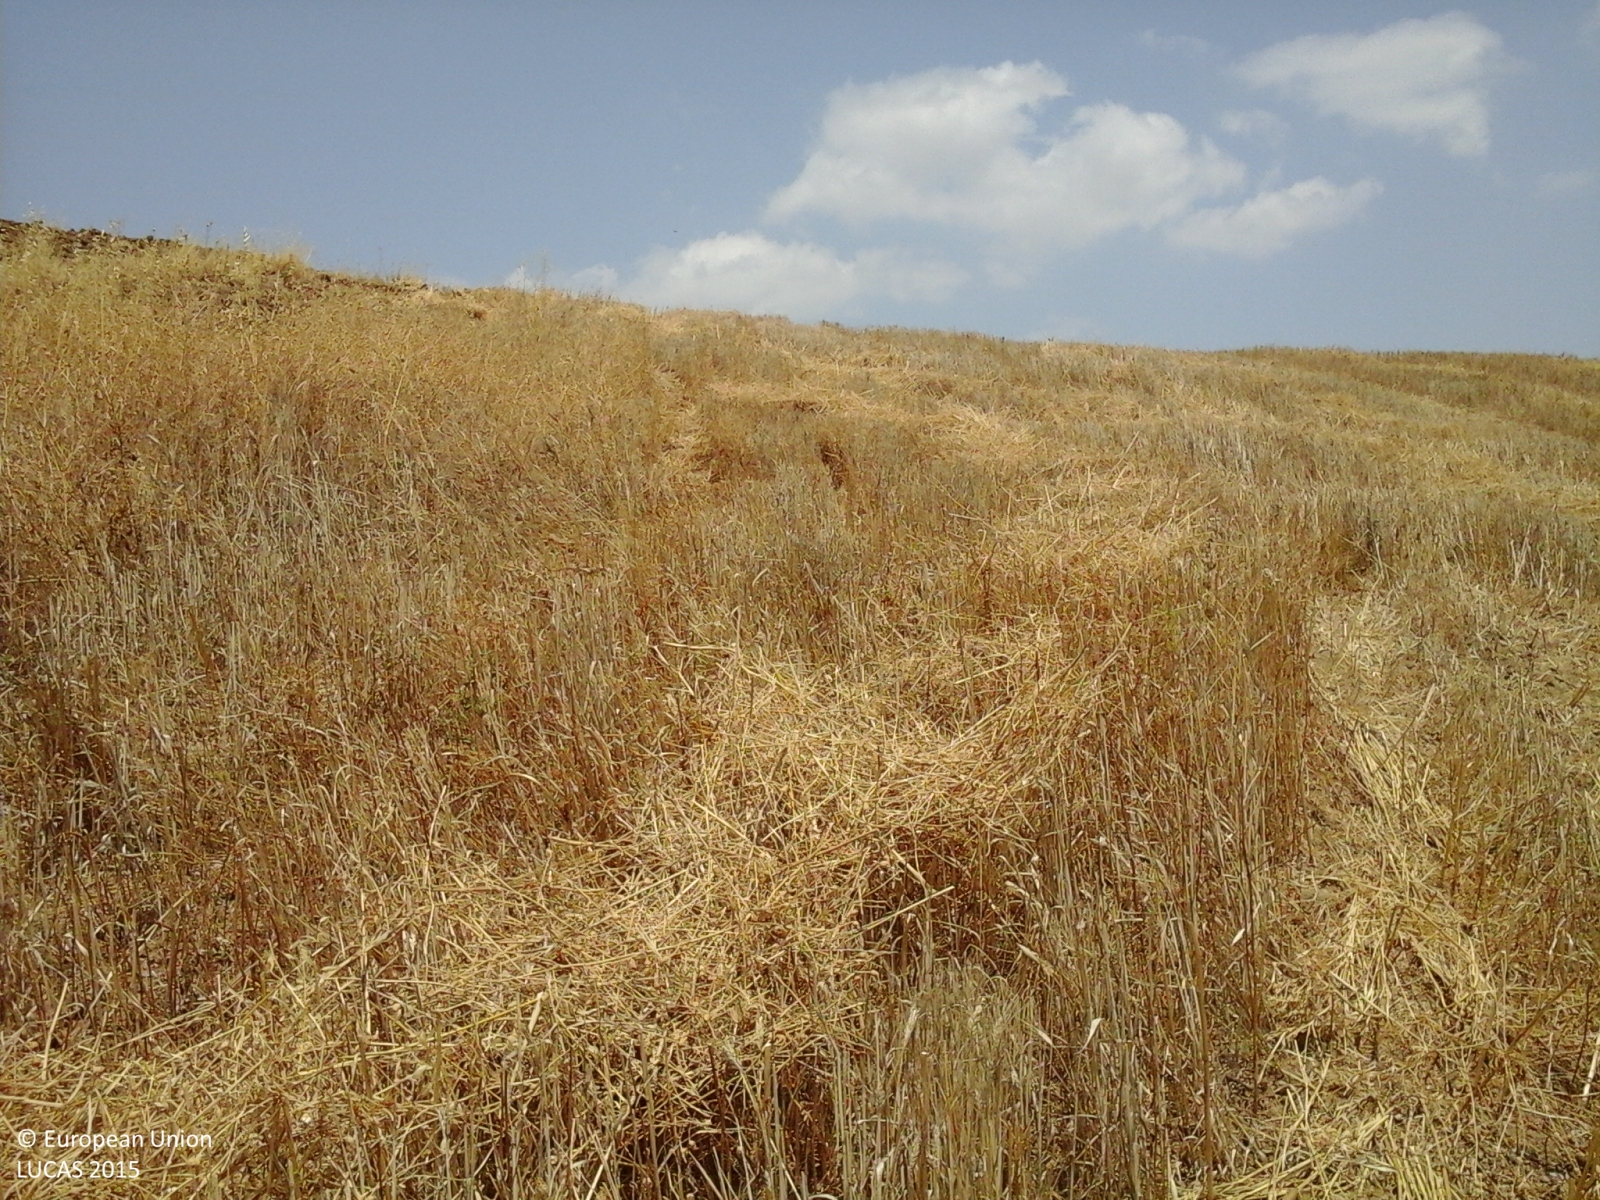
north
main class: Cropland
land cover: Durum wheat
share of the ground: > 75 %
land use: Agriculture (excluding fallow land and kitchen gardens)
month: July
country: IT
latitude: 37.3353
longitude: 14.0211
